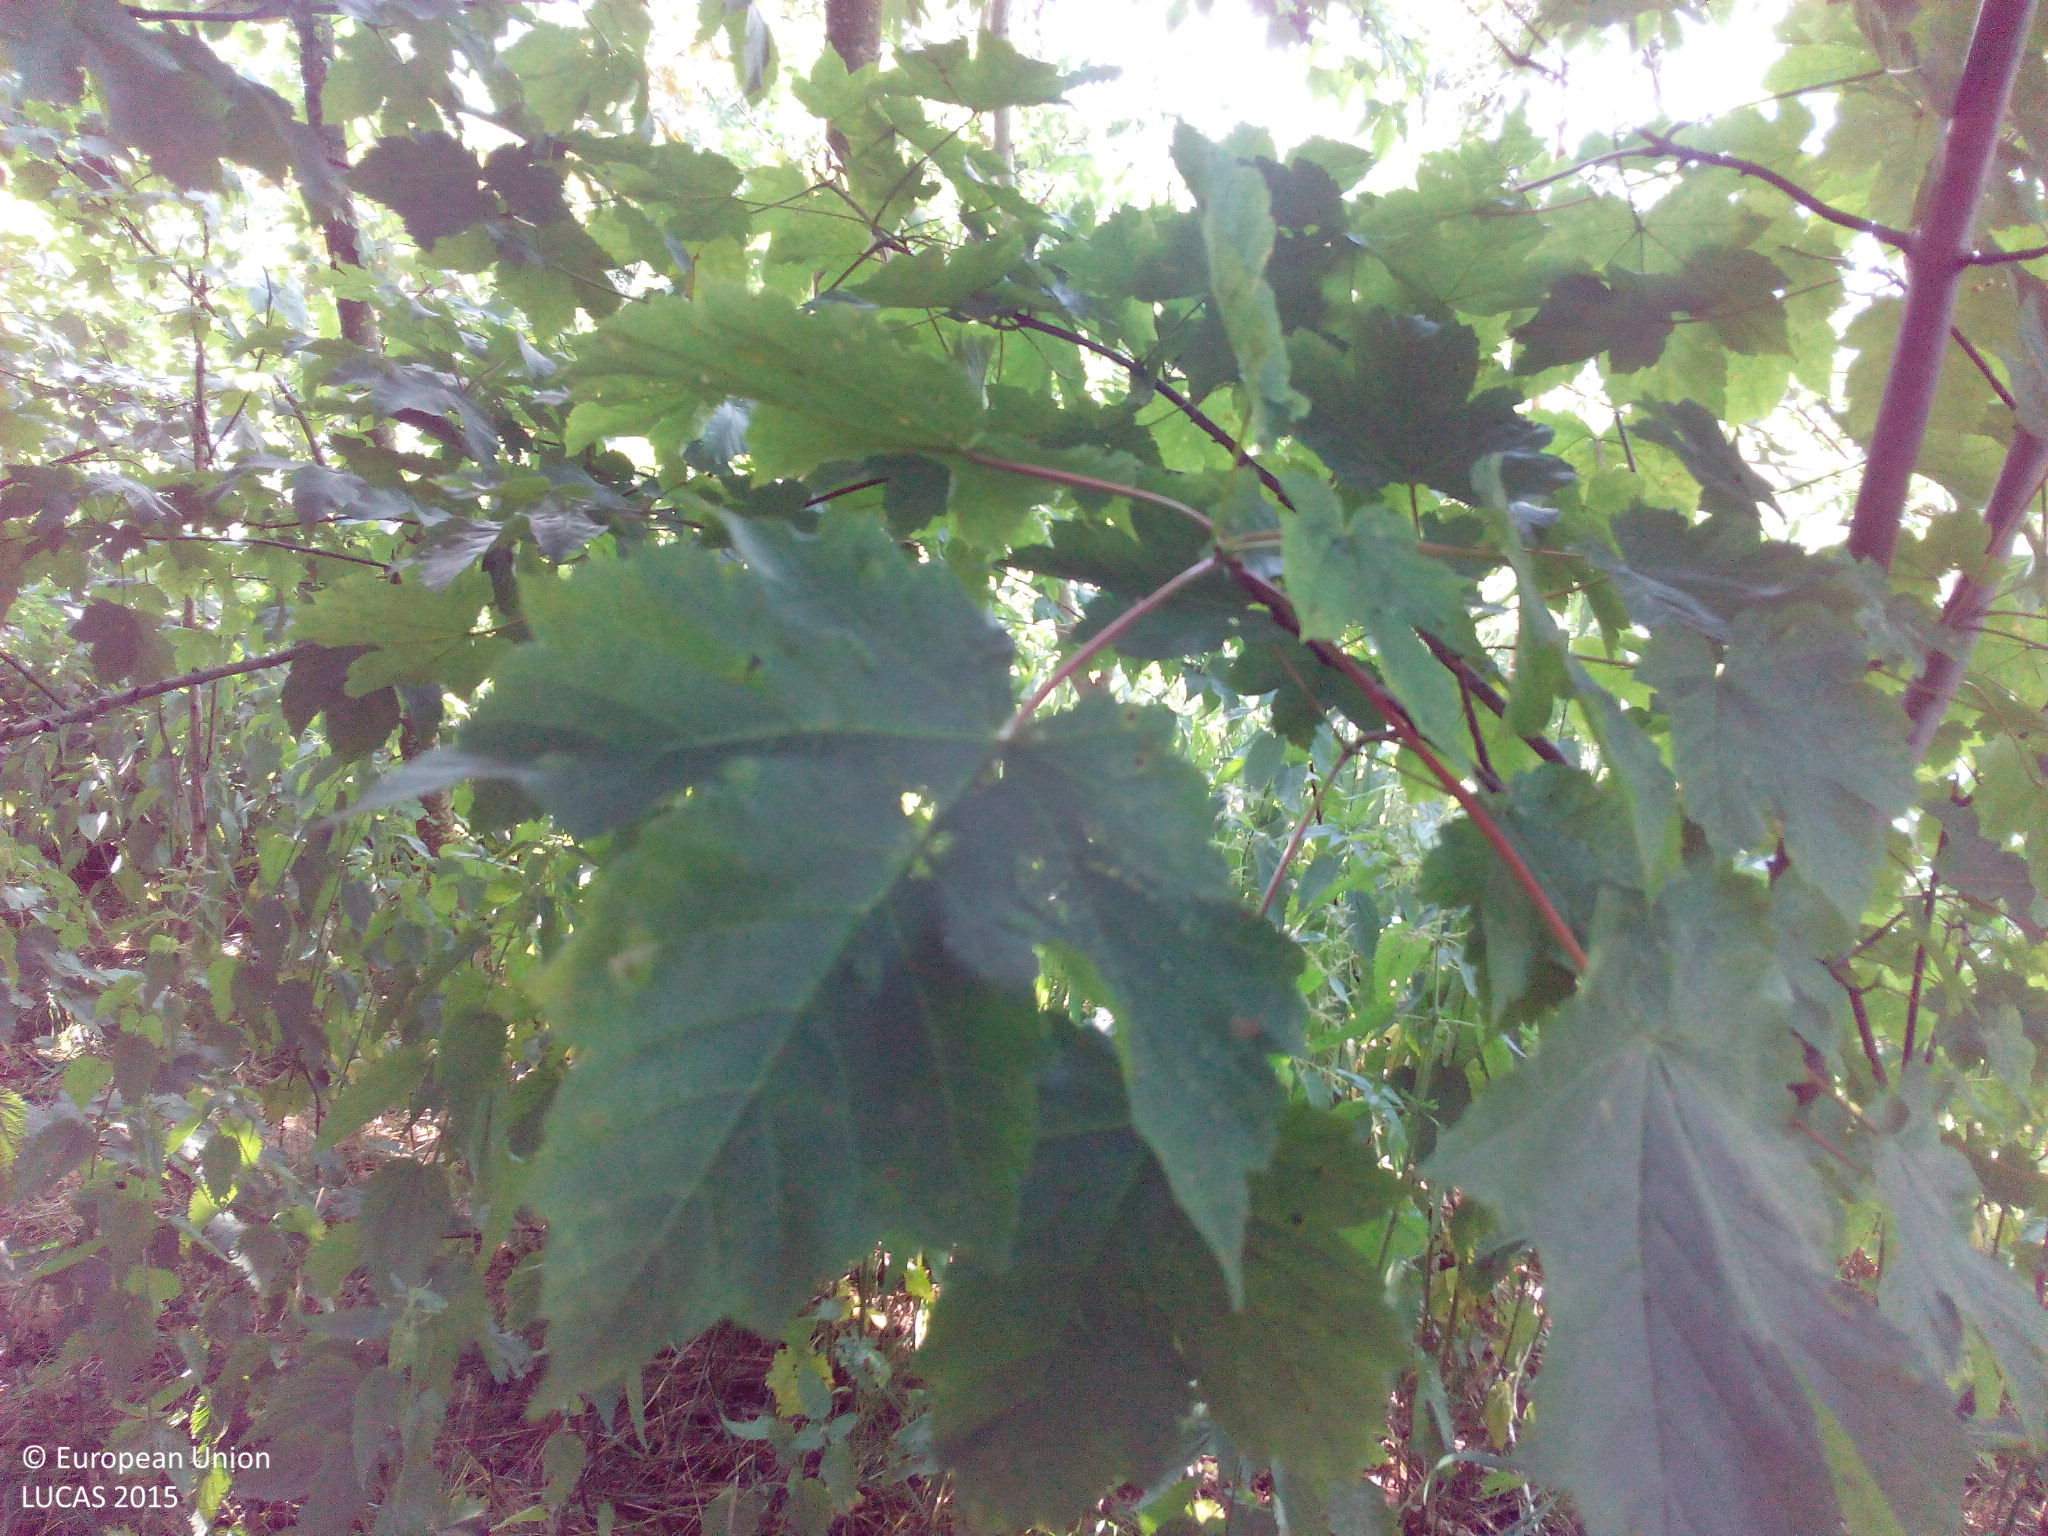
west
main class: Woodland
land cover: Broadleaved woodland
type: mesophytic deciduous forest
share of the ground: 50 - 75 %
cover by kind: broadleaved forest trees 75 %, herbaceous plants 25 %
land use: Forestry
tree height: < 5 m
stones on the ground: < 10 %
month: July
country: DE
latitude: 48.5290
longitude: 9.6887
